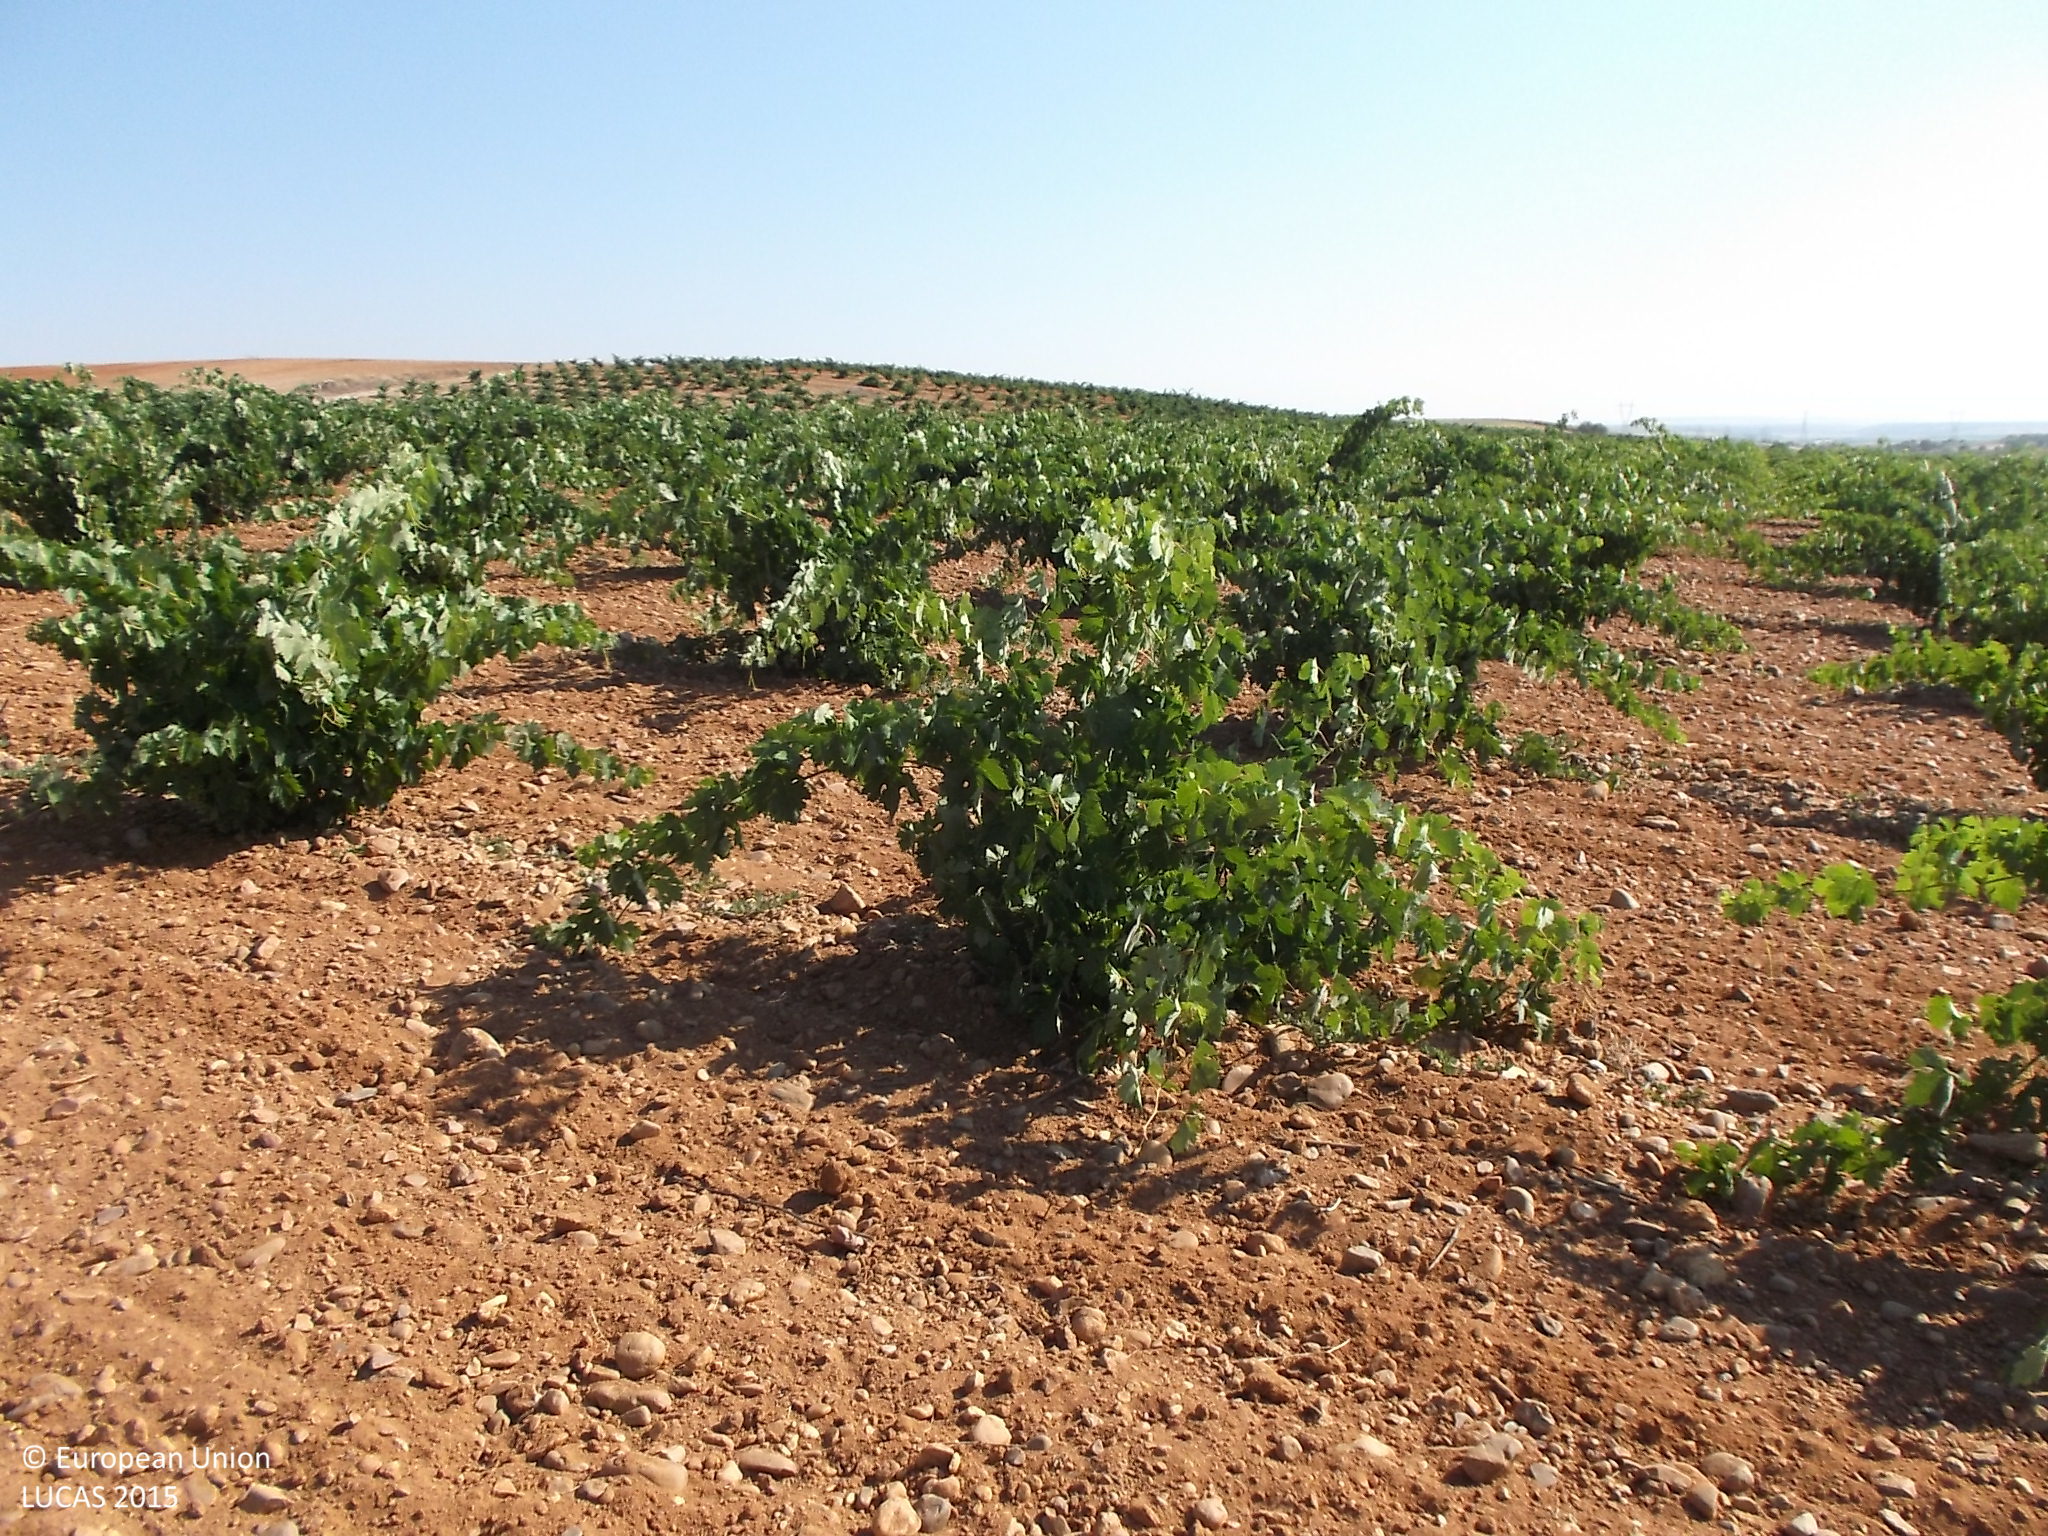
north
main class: Cropland
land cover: Vineyards
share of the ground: 10 - 25 %
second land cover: Other bare soil
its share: > 75 %
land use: Agriculture (excluding fallow land and kitchen gardens)
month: July
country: ES
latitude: 41.4338
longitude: -5.3845
